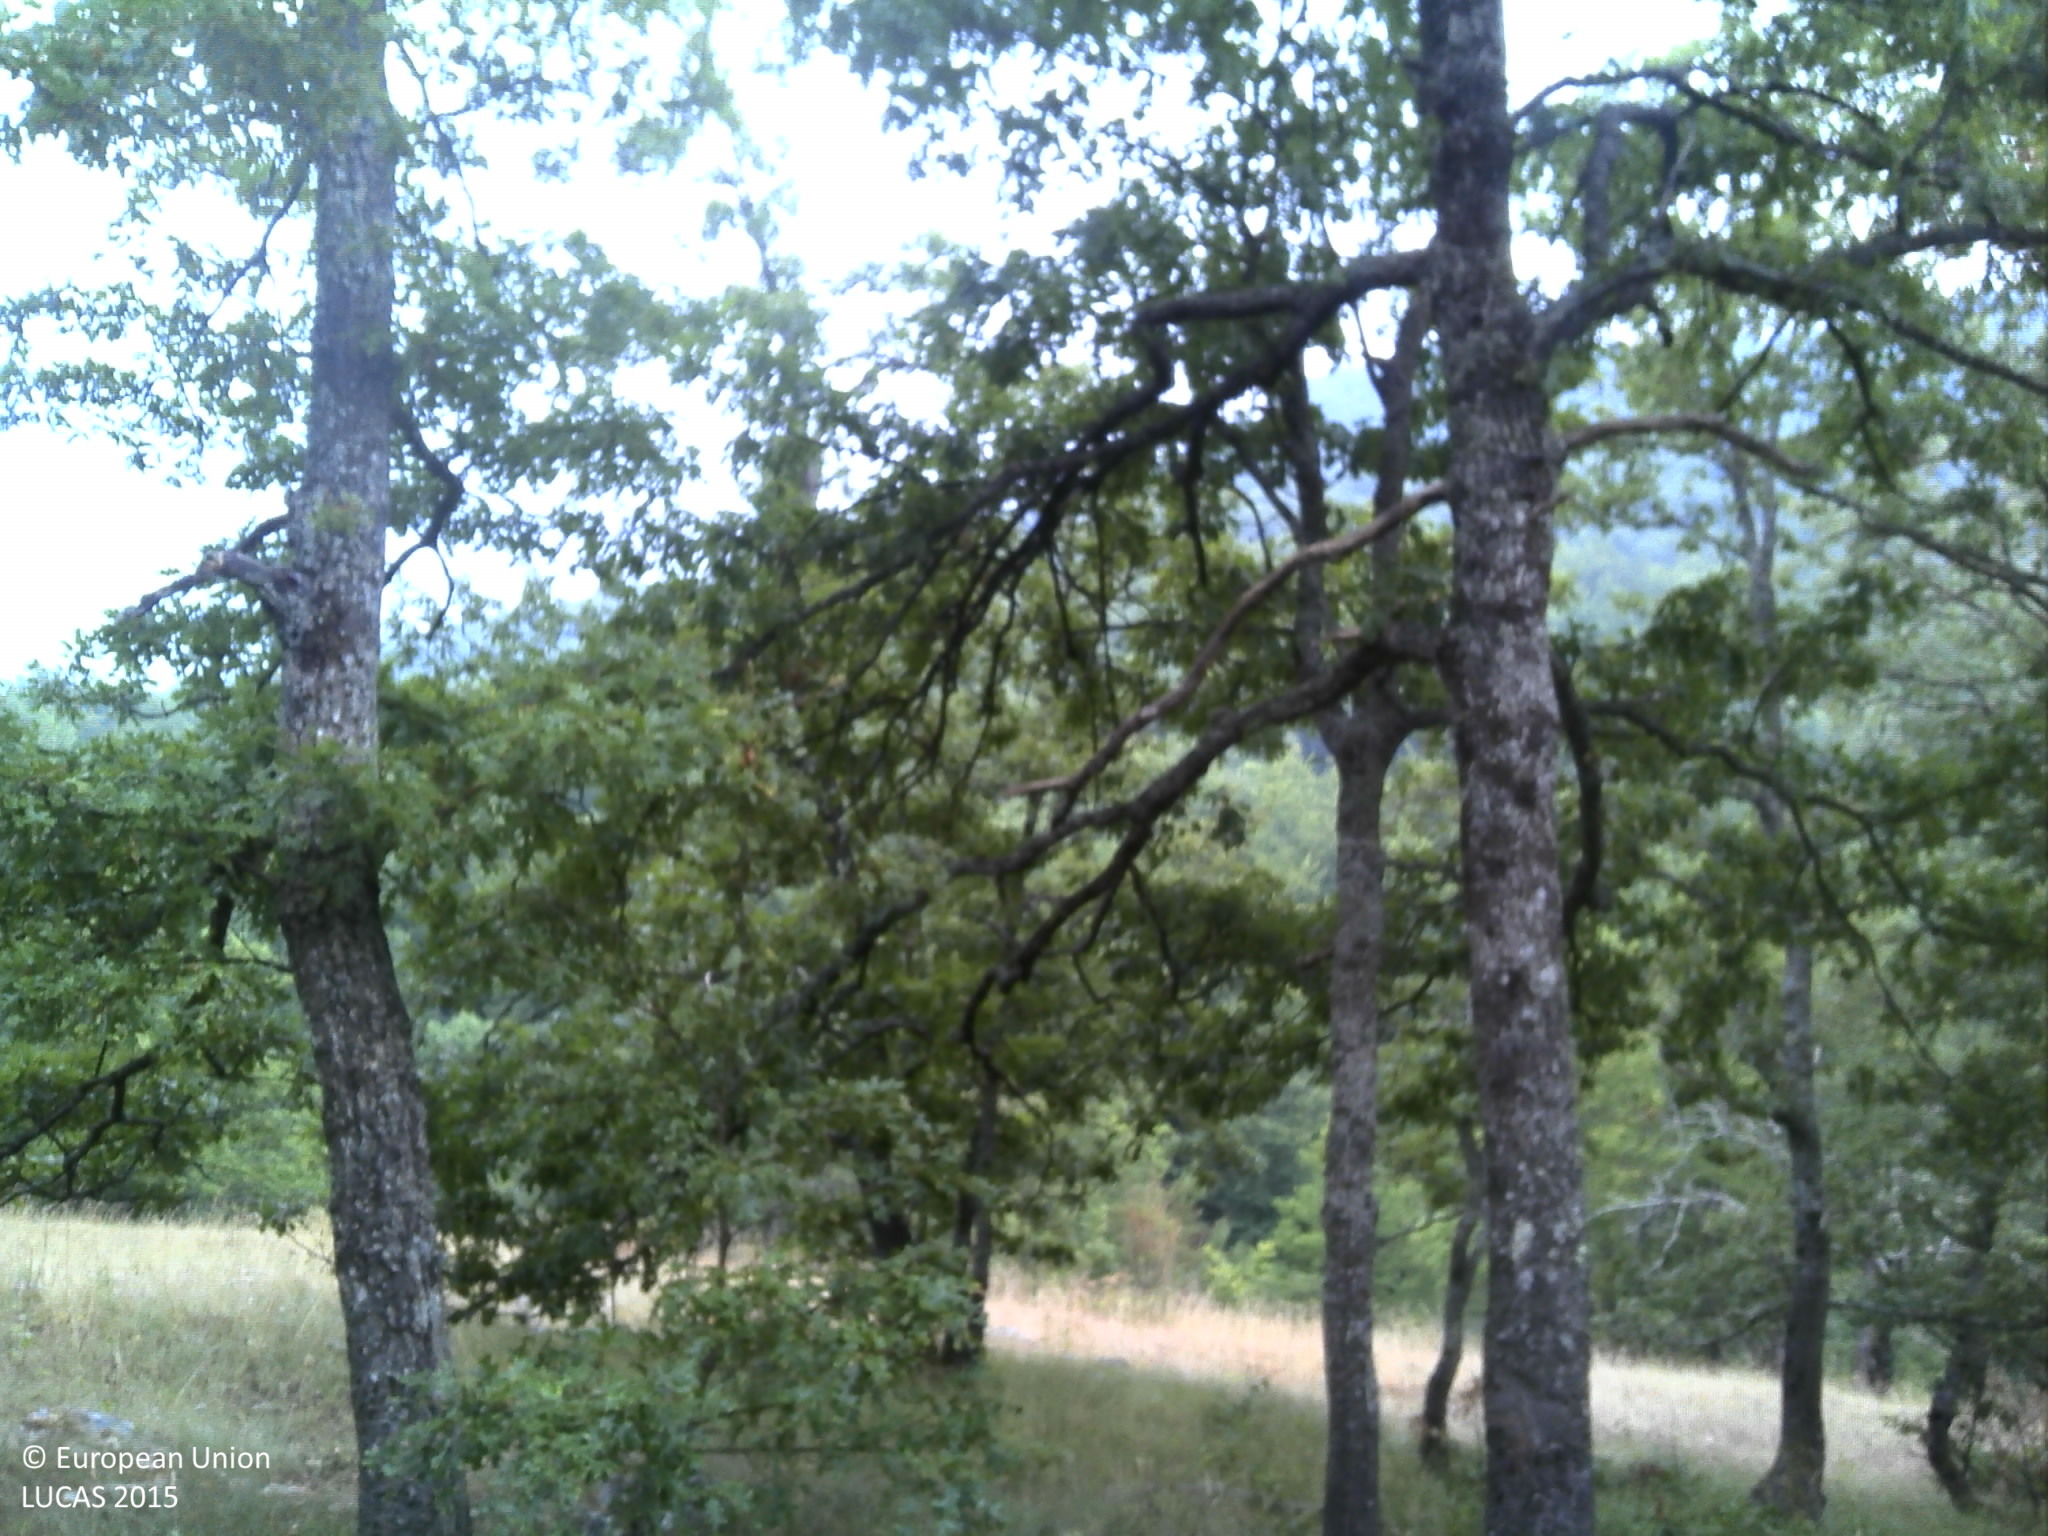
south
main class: Woodland
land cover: Broadleaved woodland
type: beech forest
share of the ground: 50 - 75 %
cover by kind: broadleaved forest trees 50 %, herbaceous plants 40 %, shrubs 10 %
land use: Semi-natural and natural areas not in use
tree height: > 5 m
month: July
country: HR
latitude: 44.4265
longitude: 16.0608
